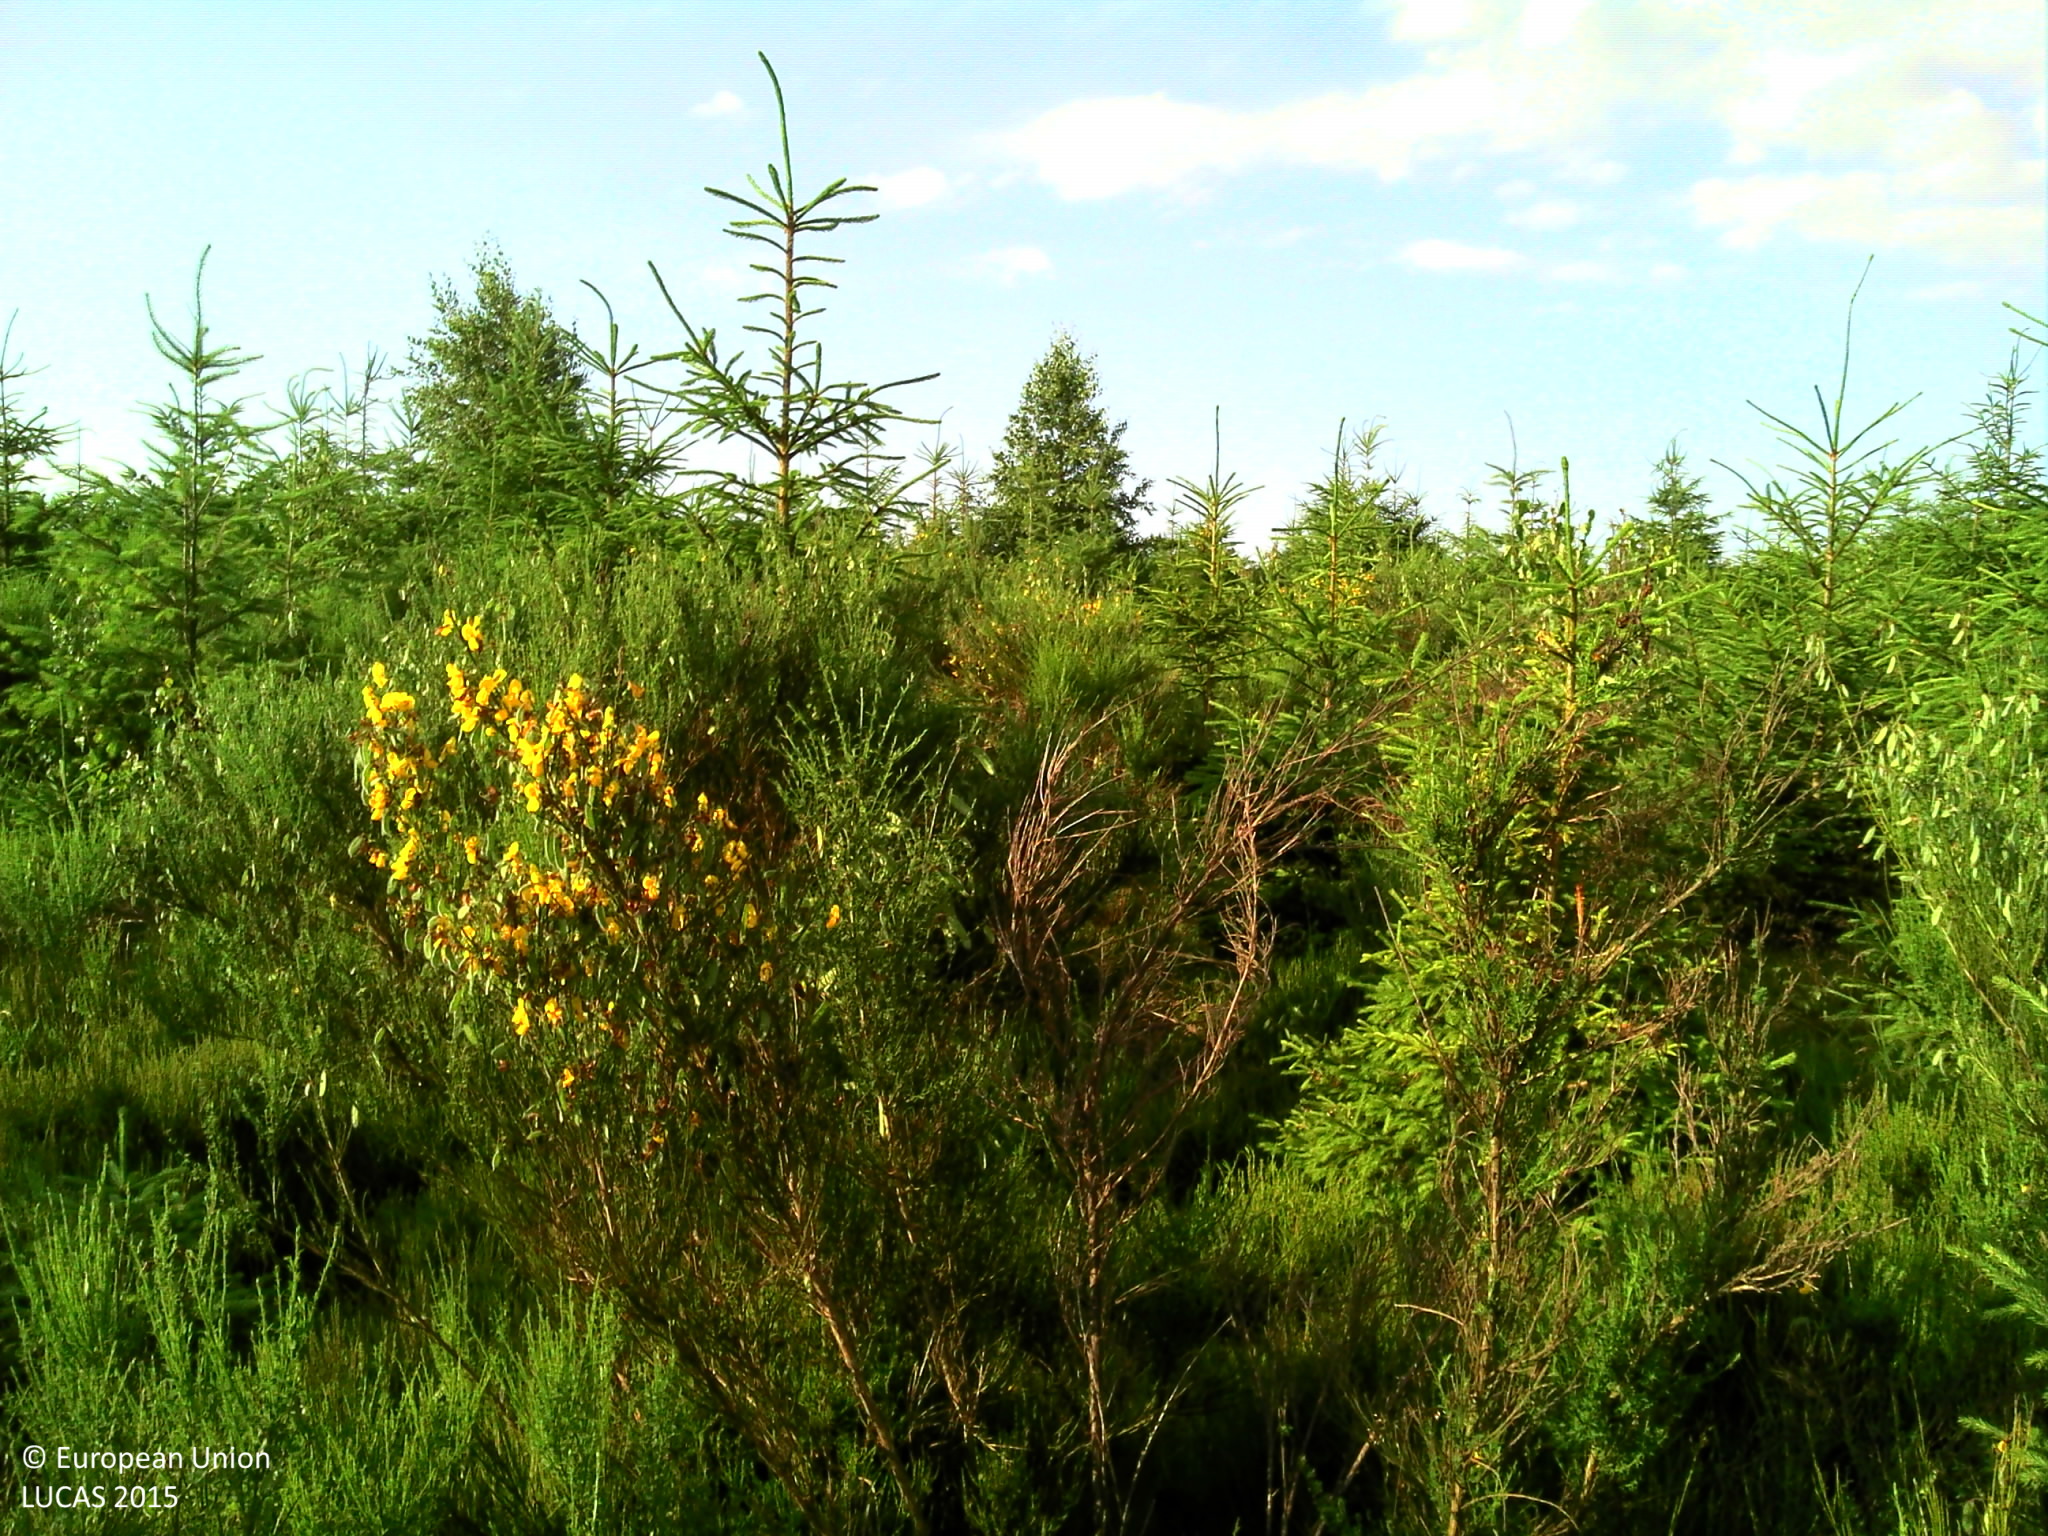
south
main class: Cropland
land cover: Nurseries
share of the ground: > 75 %
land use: Forestry
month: July
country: BE
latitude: 50.2322
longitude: 5.7790
